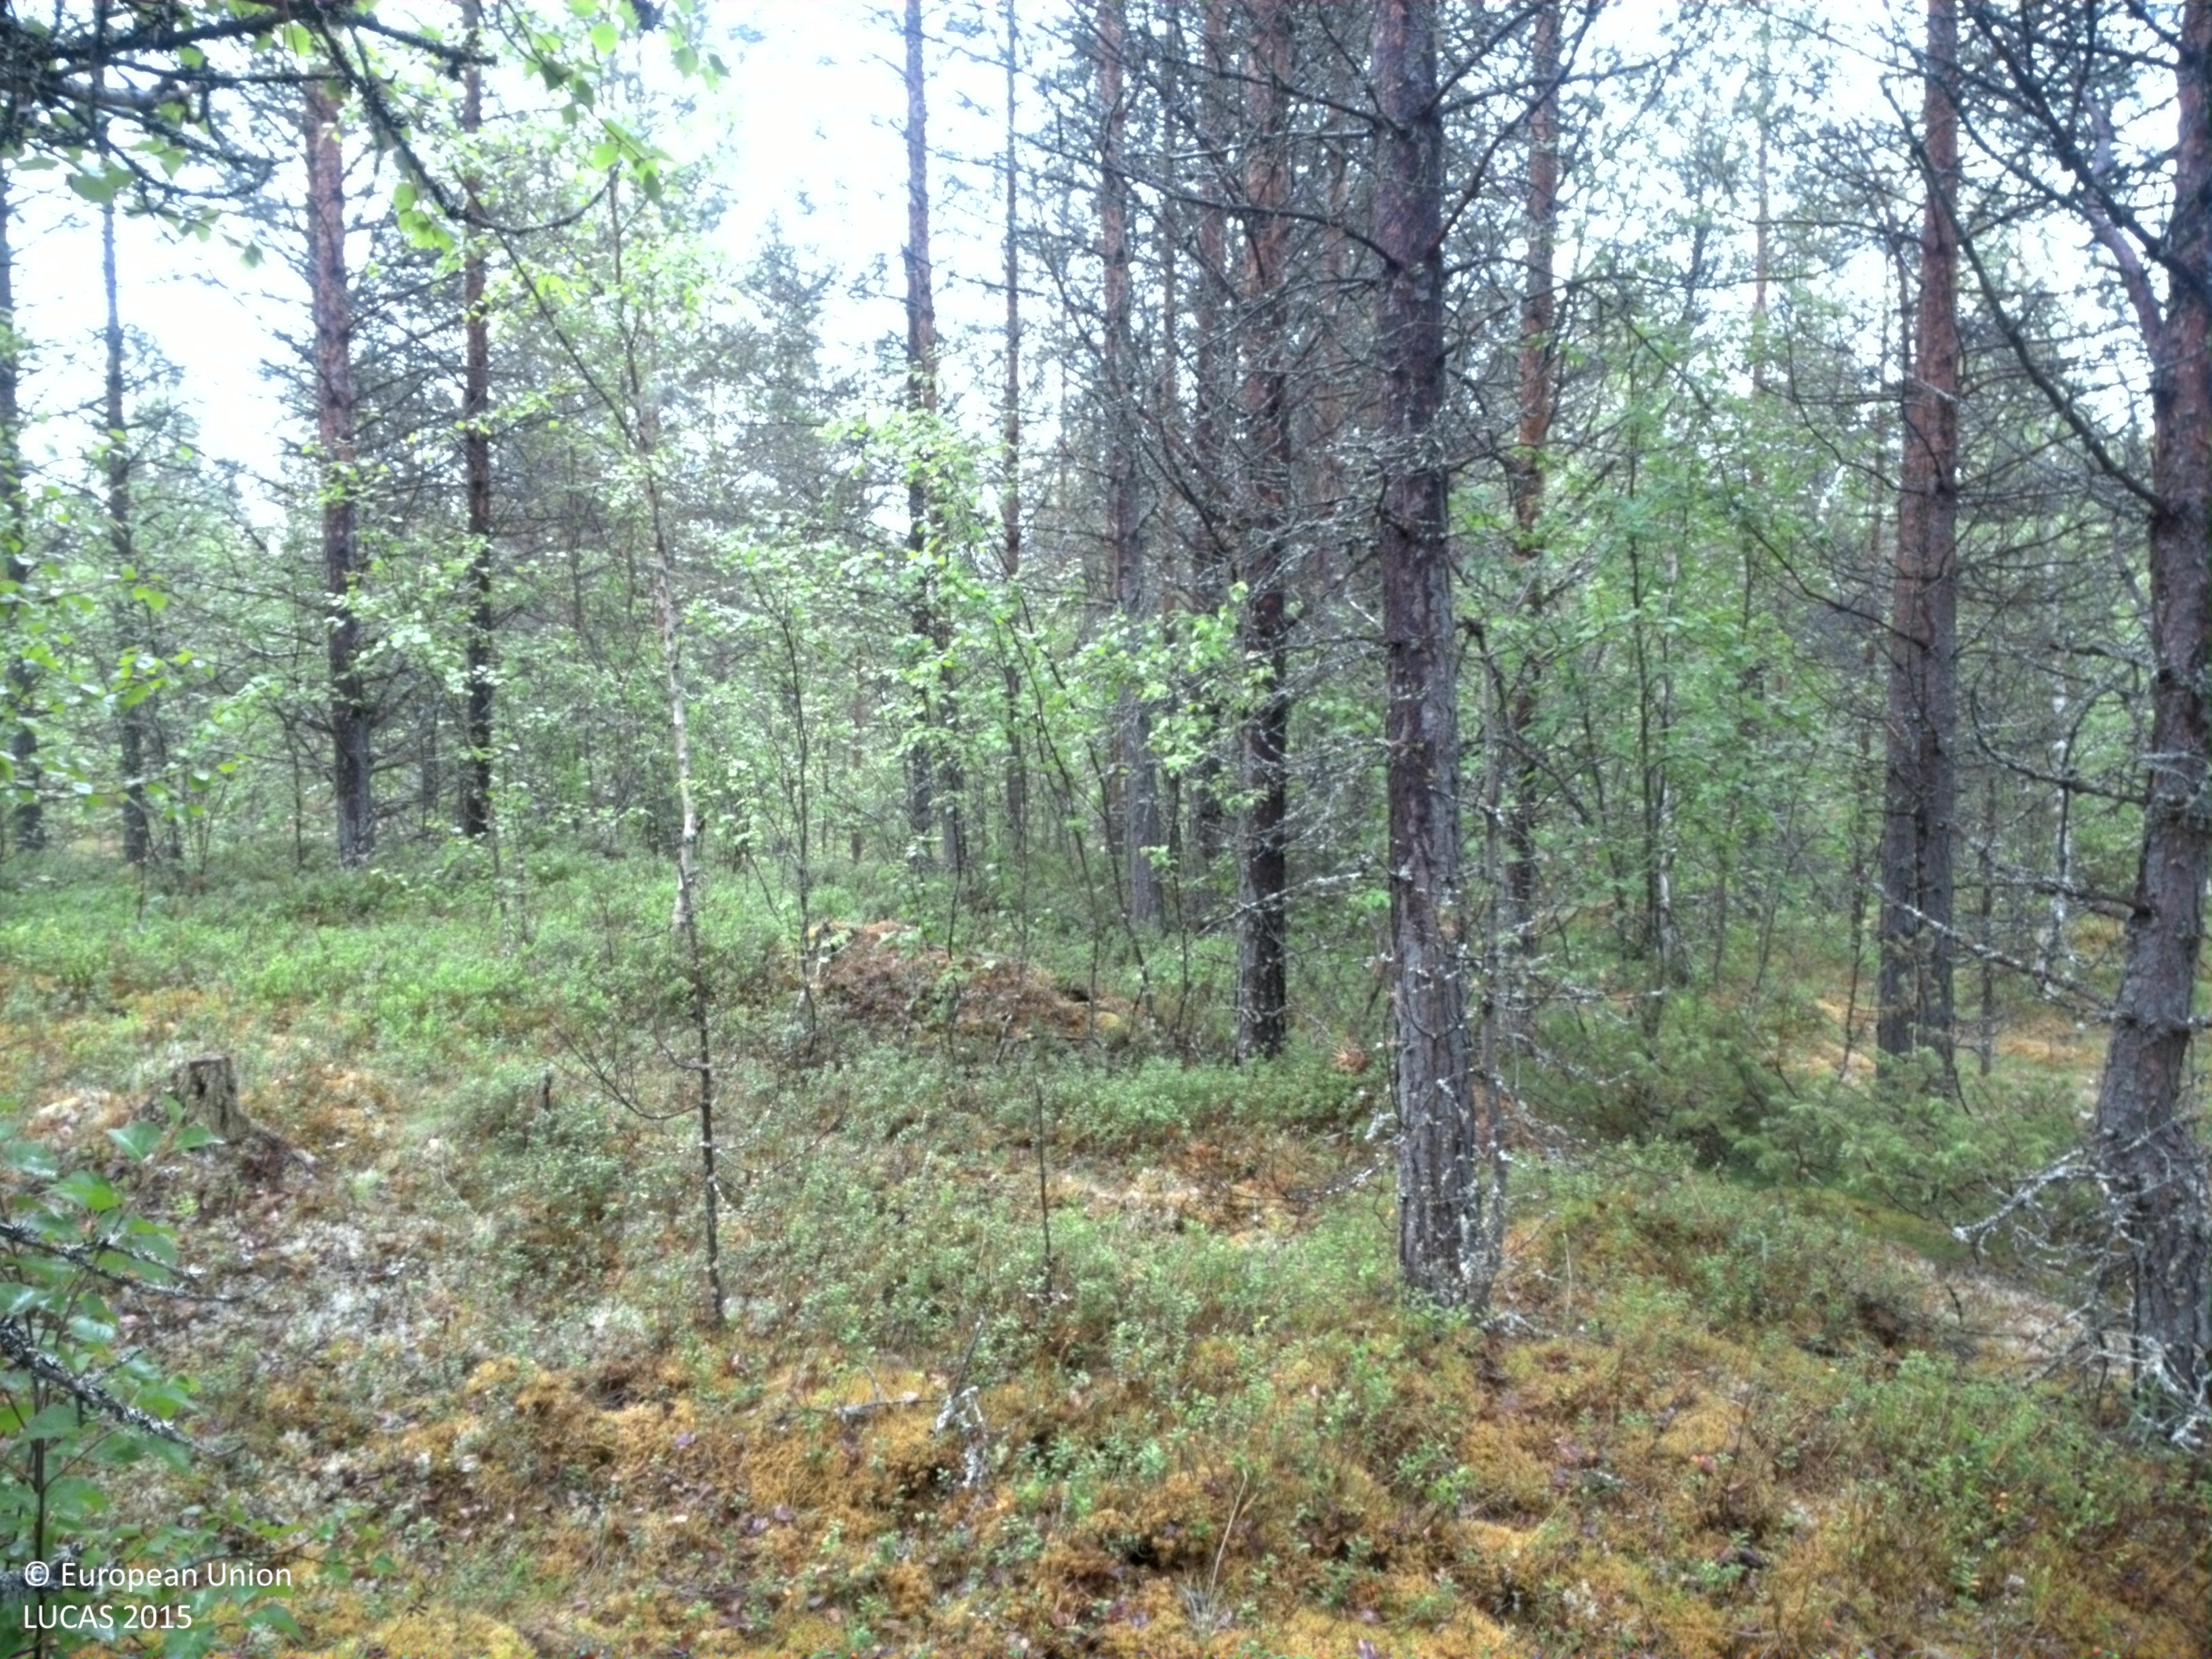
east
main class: Woodland
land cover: Pine dominated mixed woodland
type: boreal forest
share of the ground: 50 - 75 %
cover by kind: coniferous forest trees 45 %, shrubs 25 %, broadleaved forest trees 15 %, lichens and mosses 15 %
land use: Forestry
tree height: > 5 m
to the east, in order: Pine dominated mixed woodland; Pine dominated coniferous woodland
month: July
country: SE
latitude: 64.5670
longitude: 18.2108
